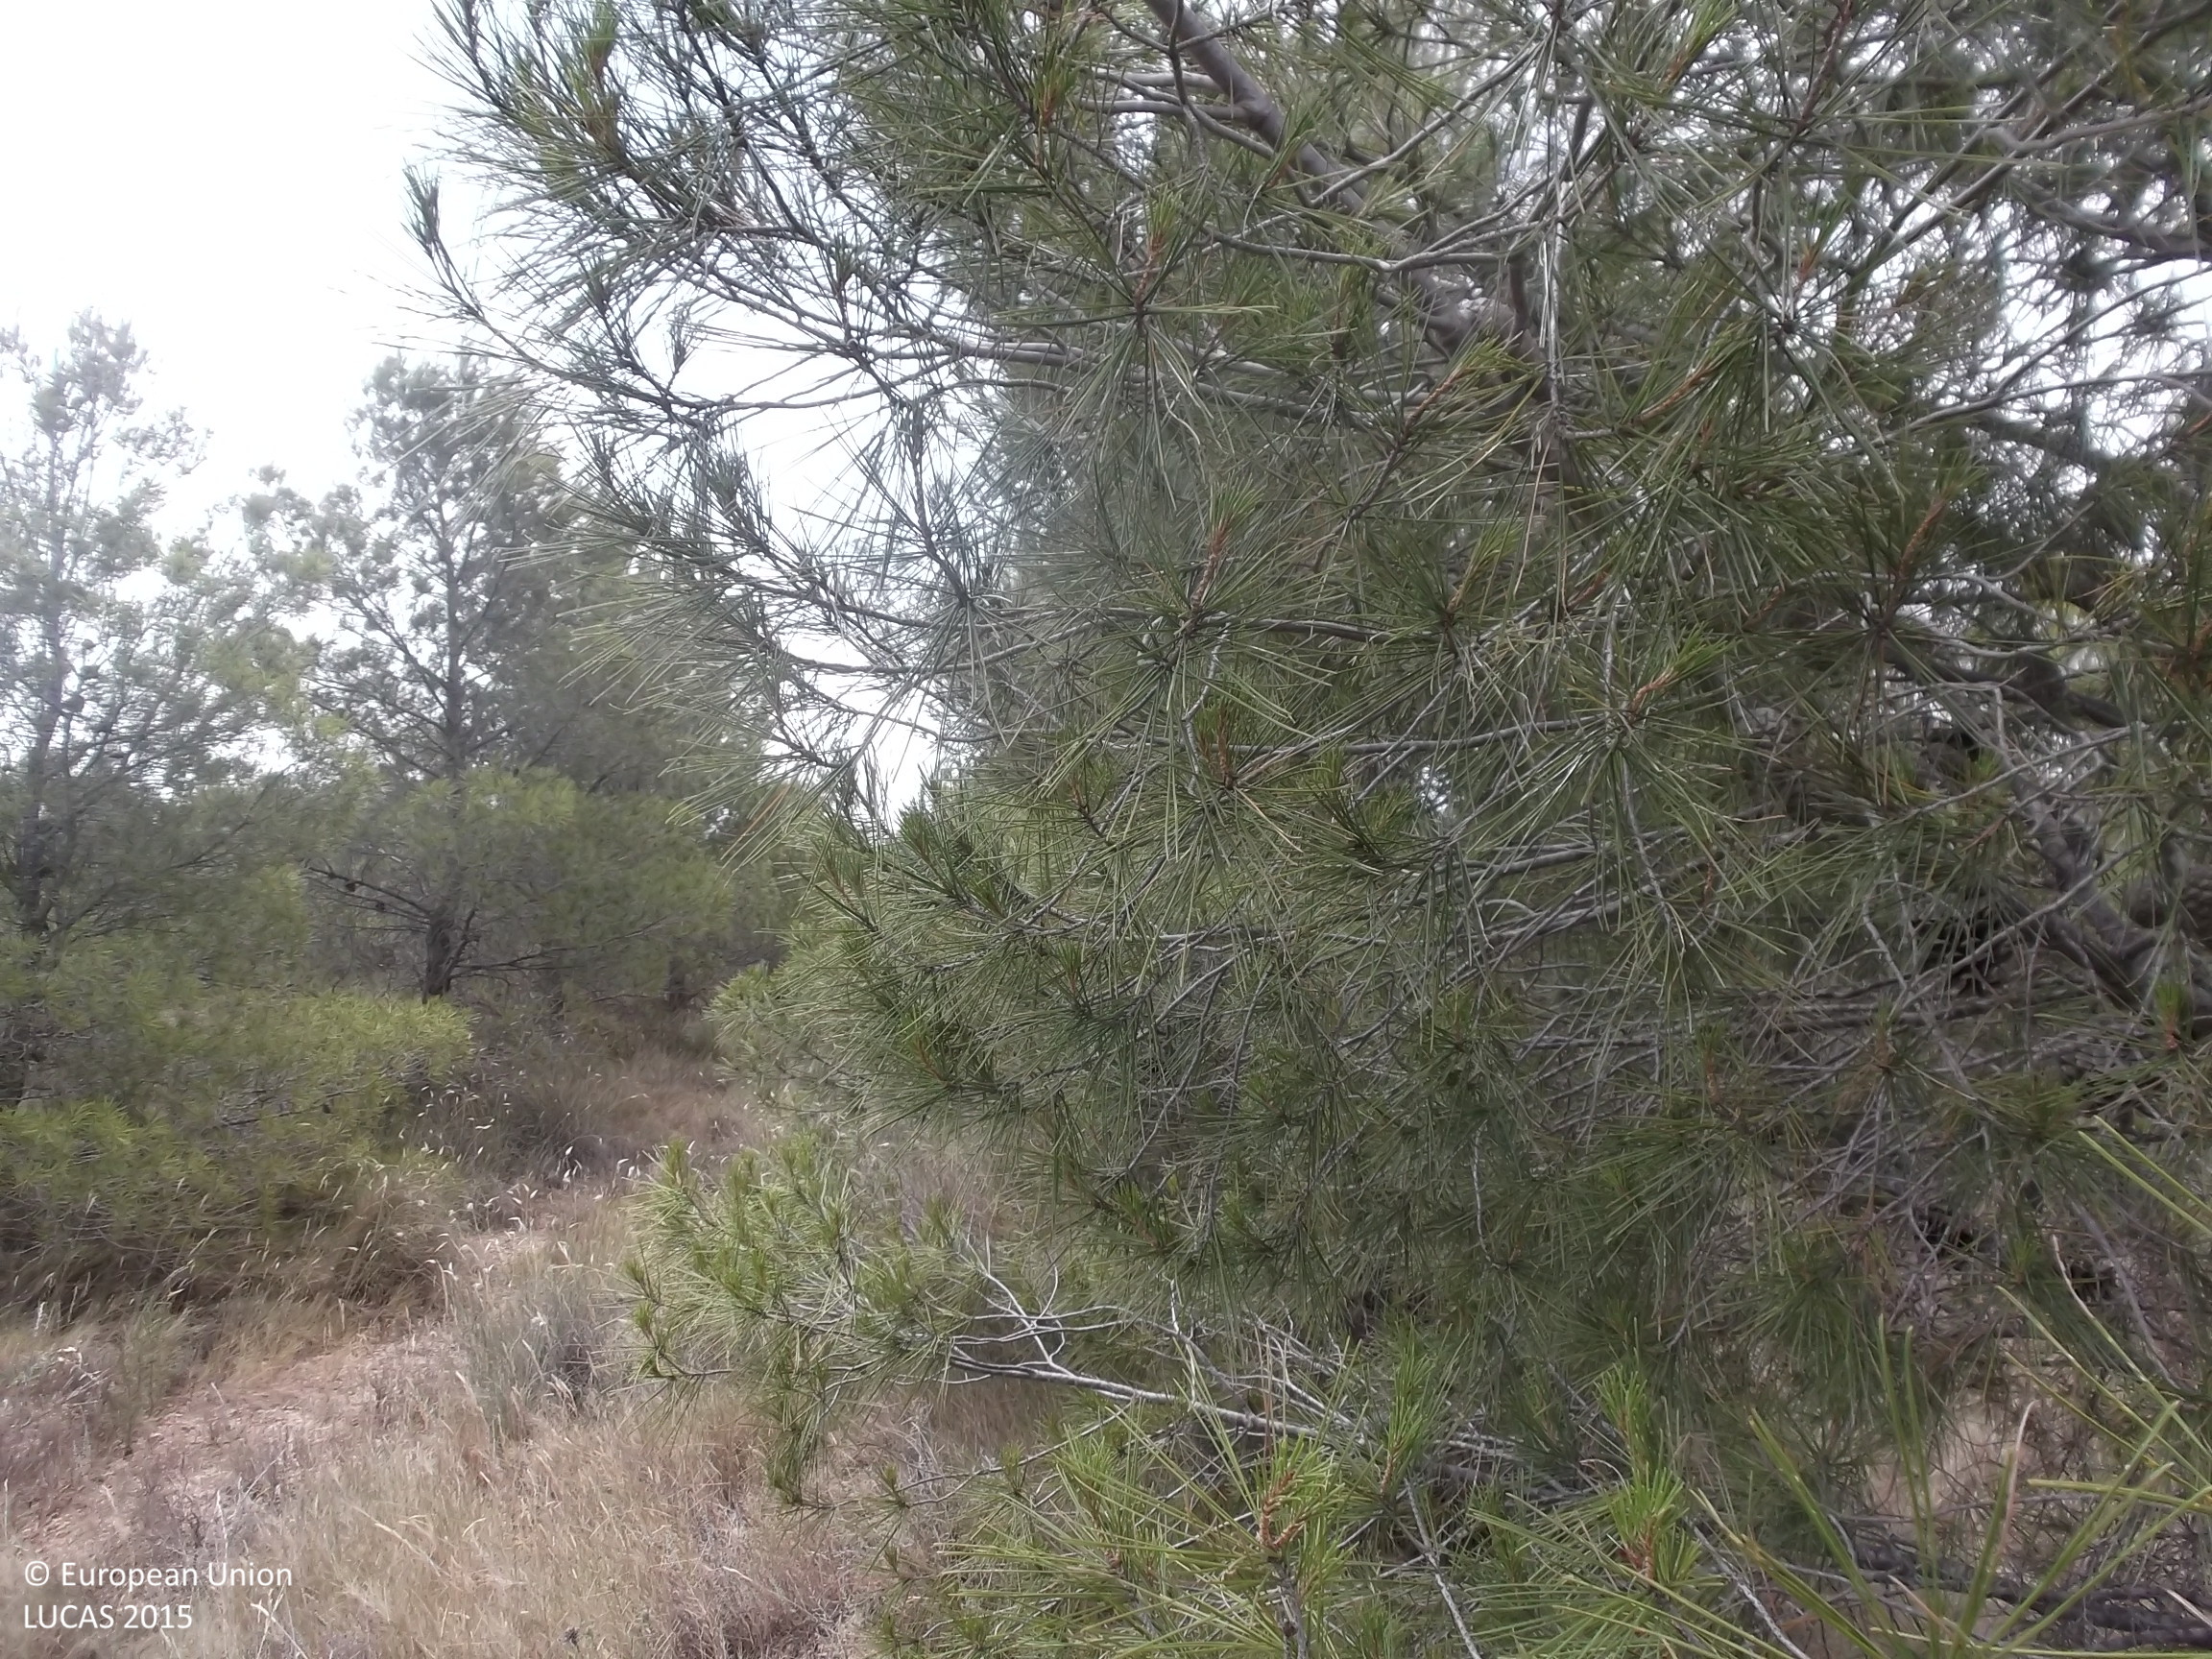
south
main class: Woodland
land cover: Pine dominated coniferous woodland
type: coniferous forest of the mediterranean region
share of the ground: 50 - 75 %
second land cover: Shrubland without tree cover
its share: 10 - 25 %
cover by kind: coniferous forest trees 70 %, shrubs 15 %, herbaceous plants 10 %, unconsolidated bare surface 5 %
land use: Forestry
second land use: Agriculture (excluding fallow land and kitchen gardens)
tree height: < 5 m
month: July
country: ES
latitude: 42.2095
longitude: -1.5518
